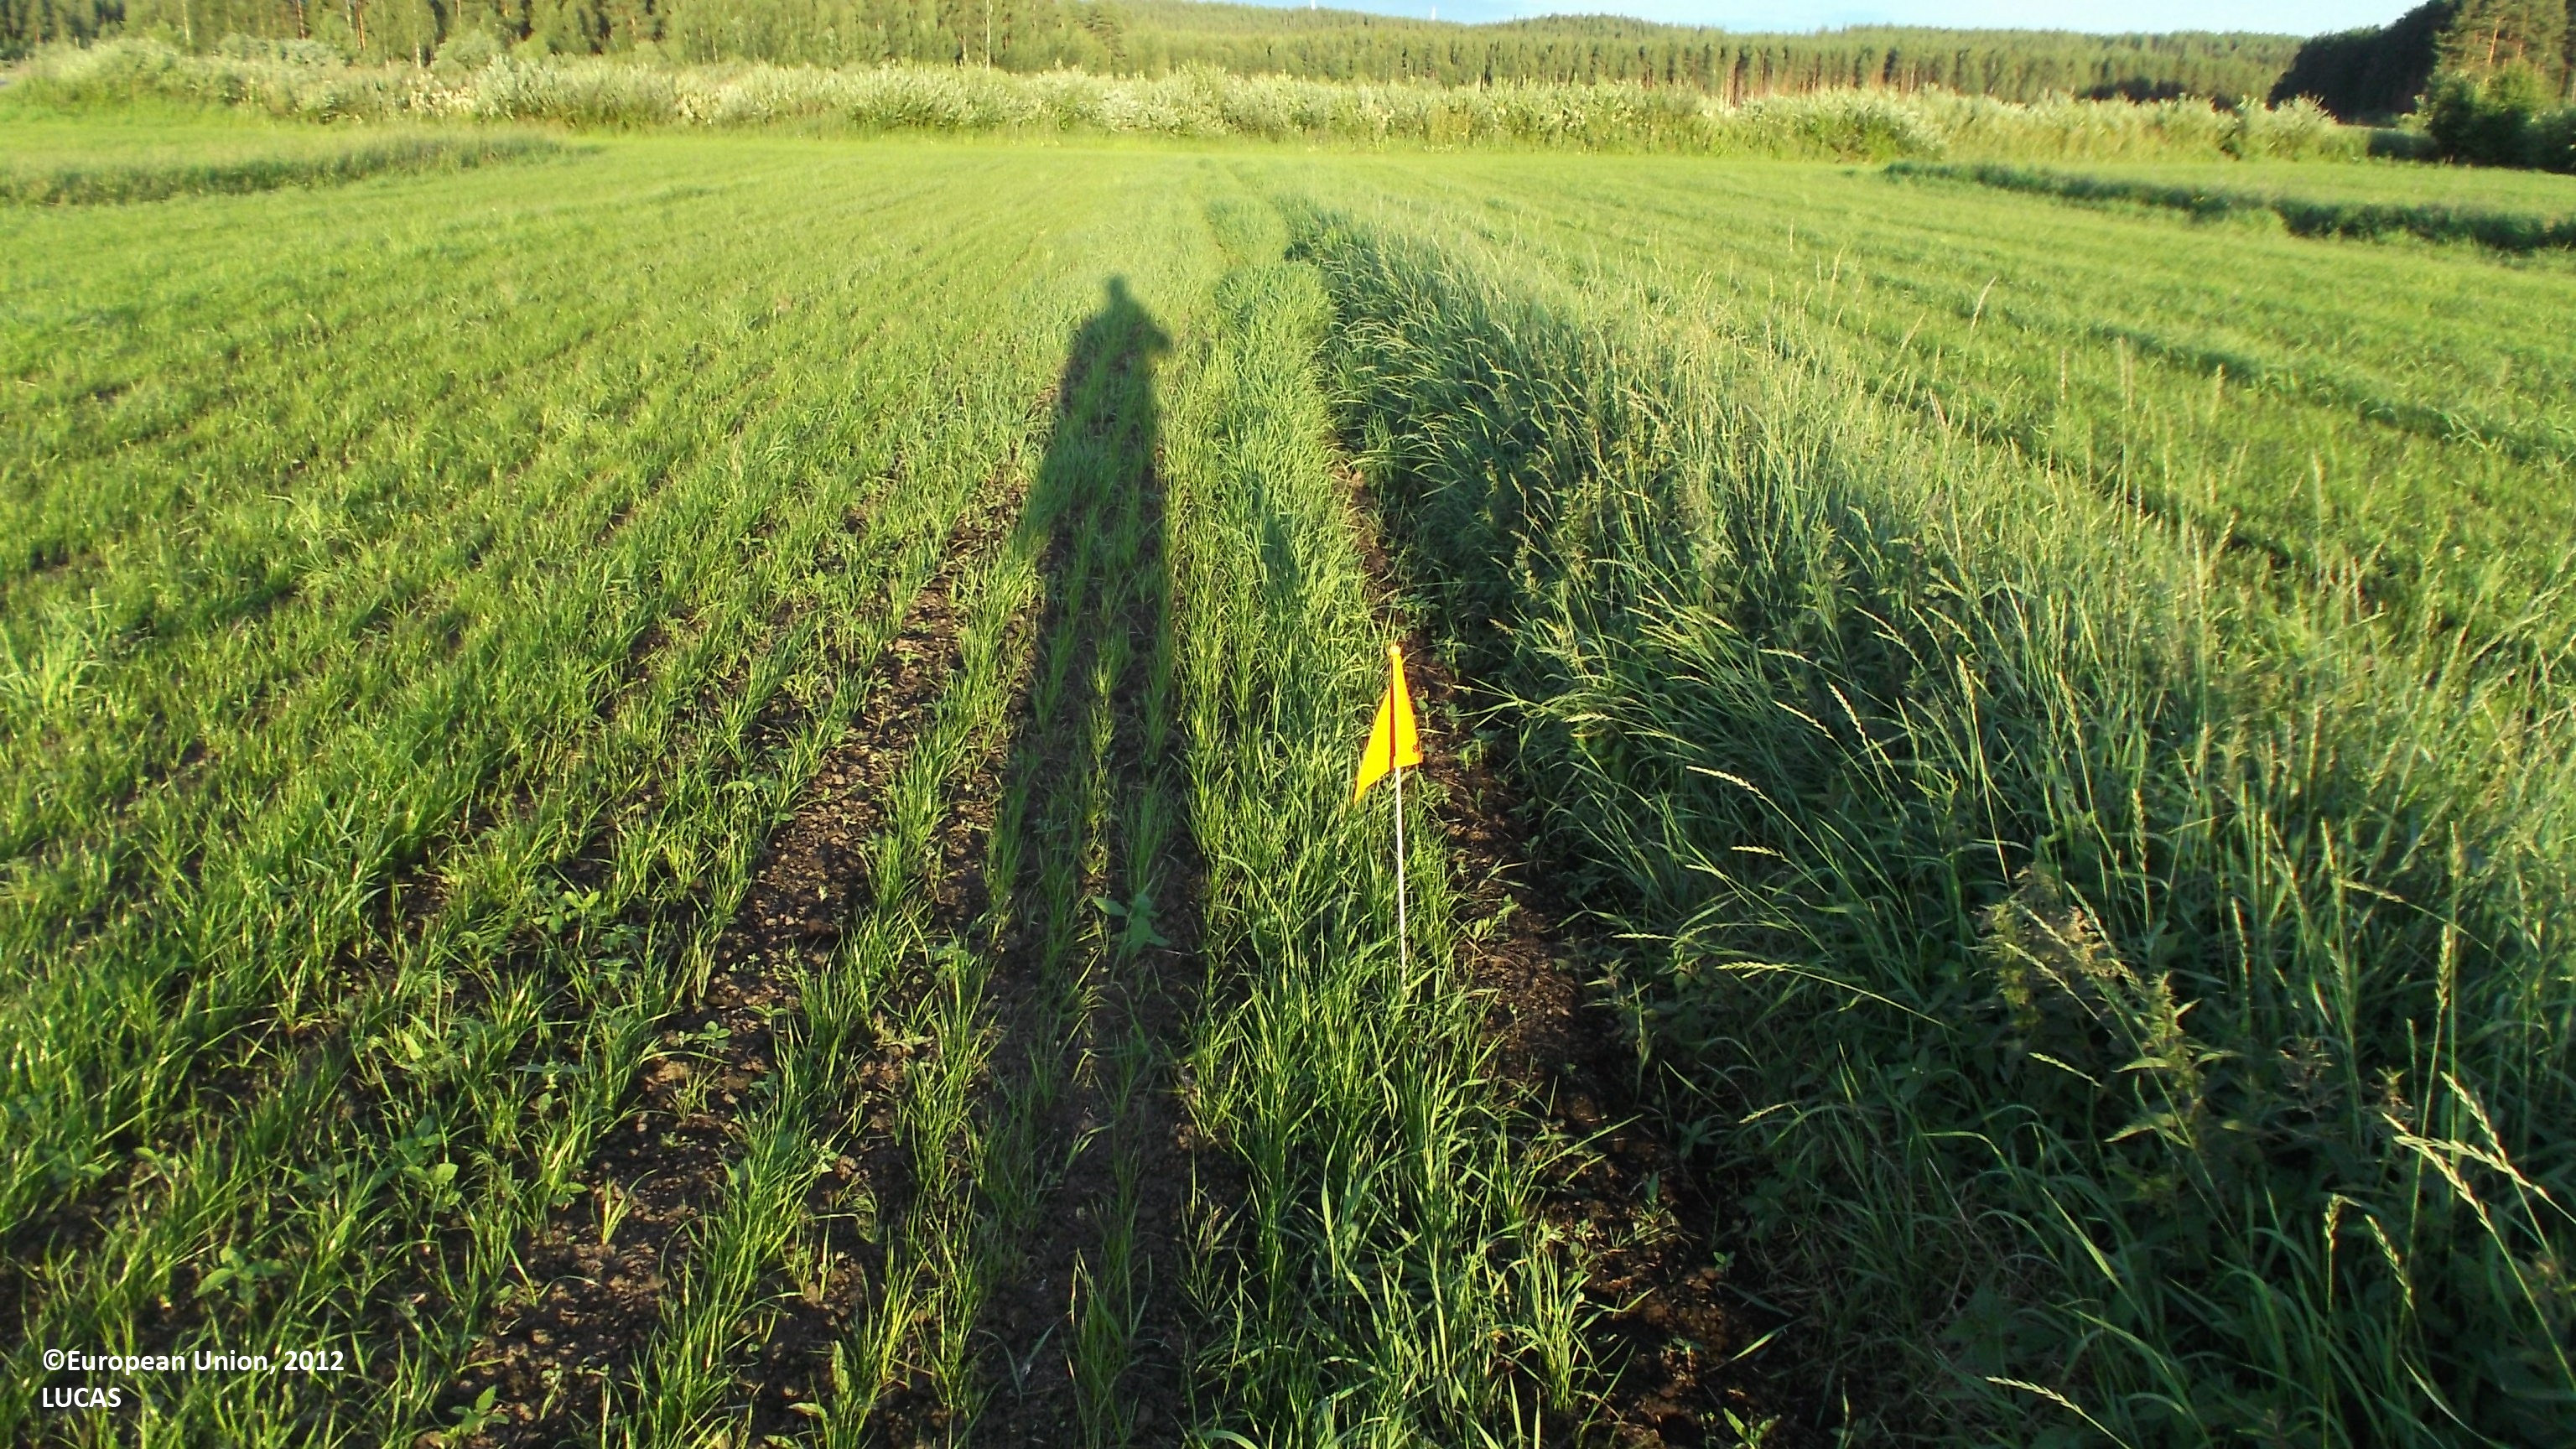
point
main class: Cropland
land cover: Temporary grasslands
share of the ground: 25 - 50 %
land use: Agriculture (excluding fallow land and kitchen gardens)
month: July
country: FI
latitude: 63.1462
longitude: 23.8219
